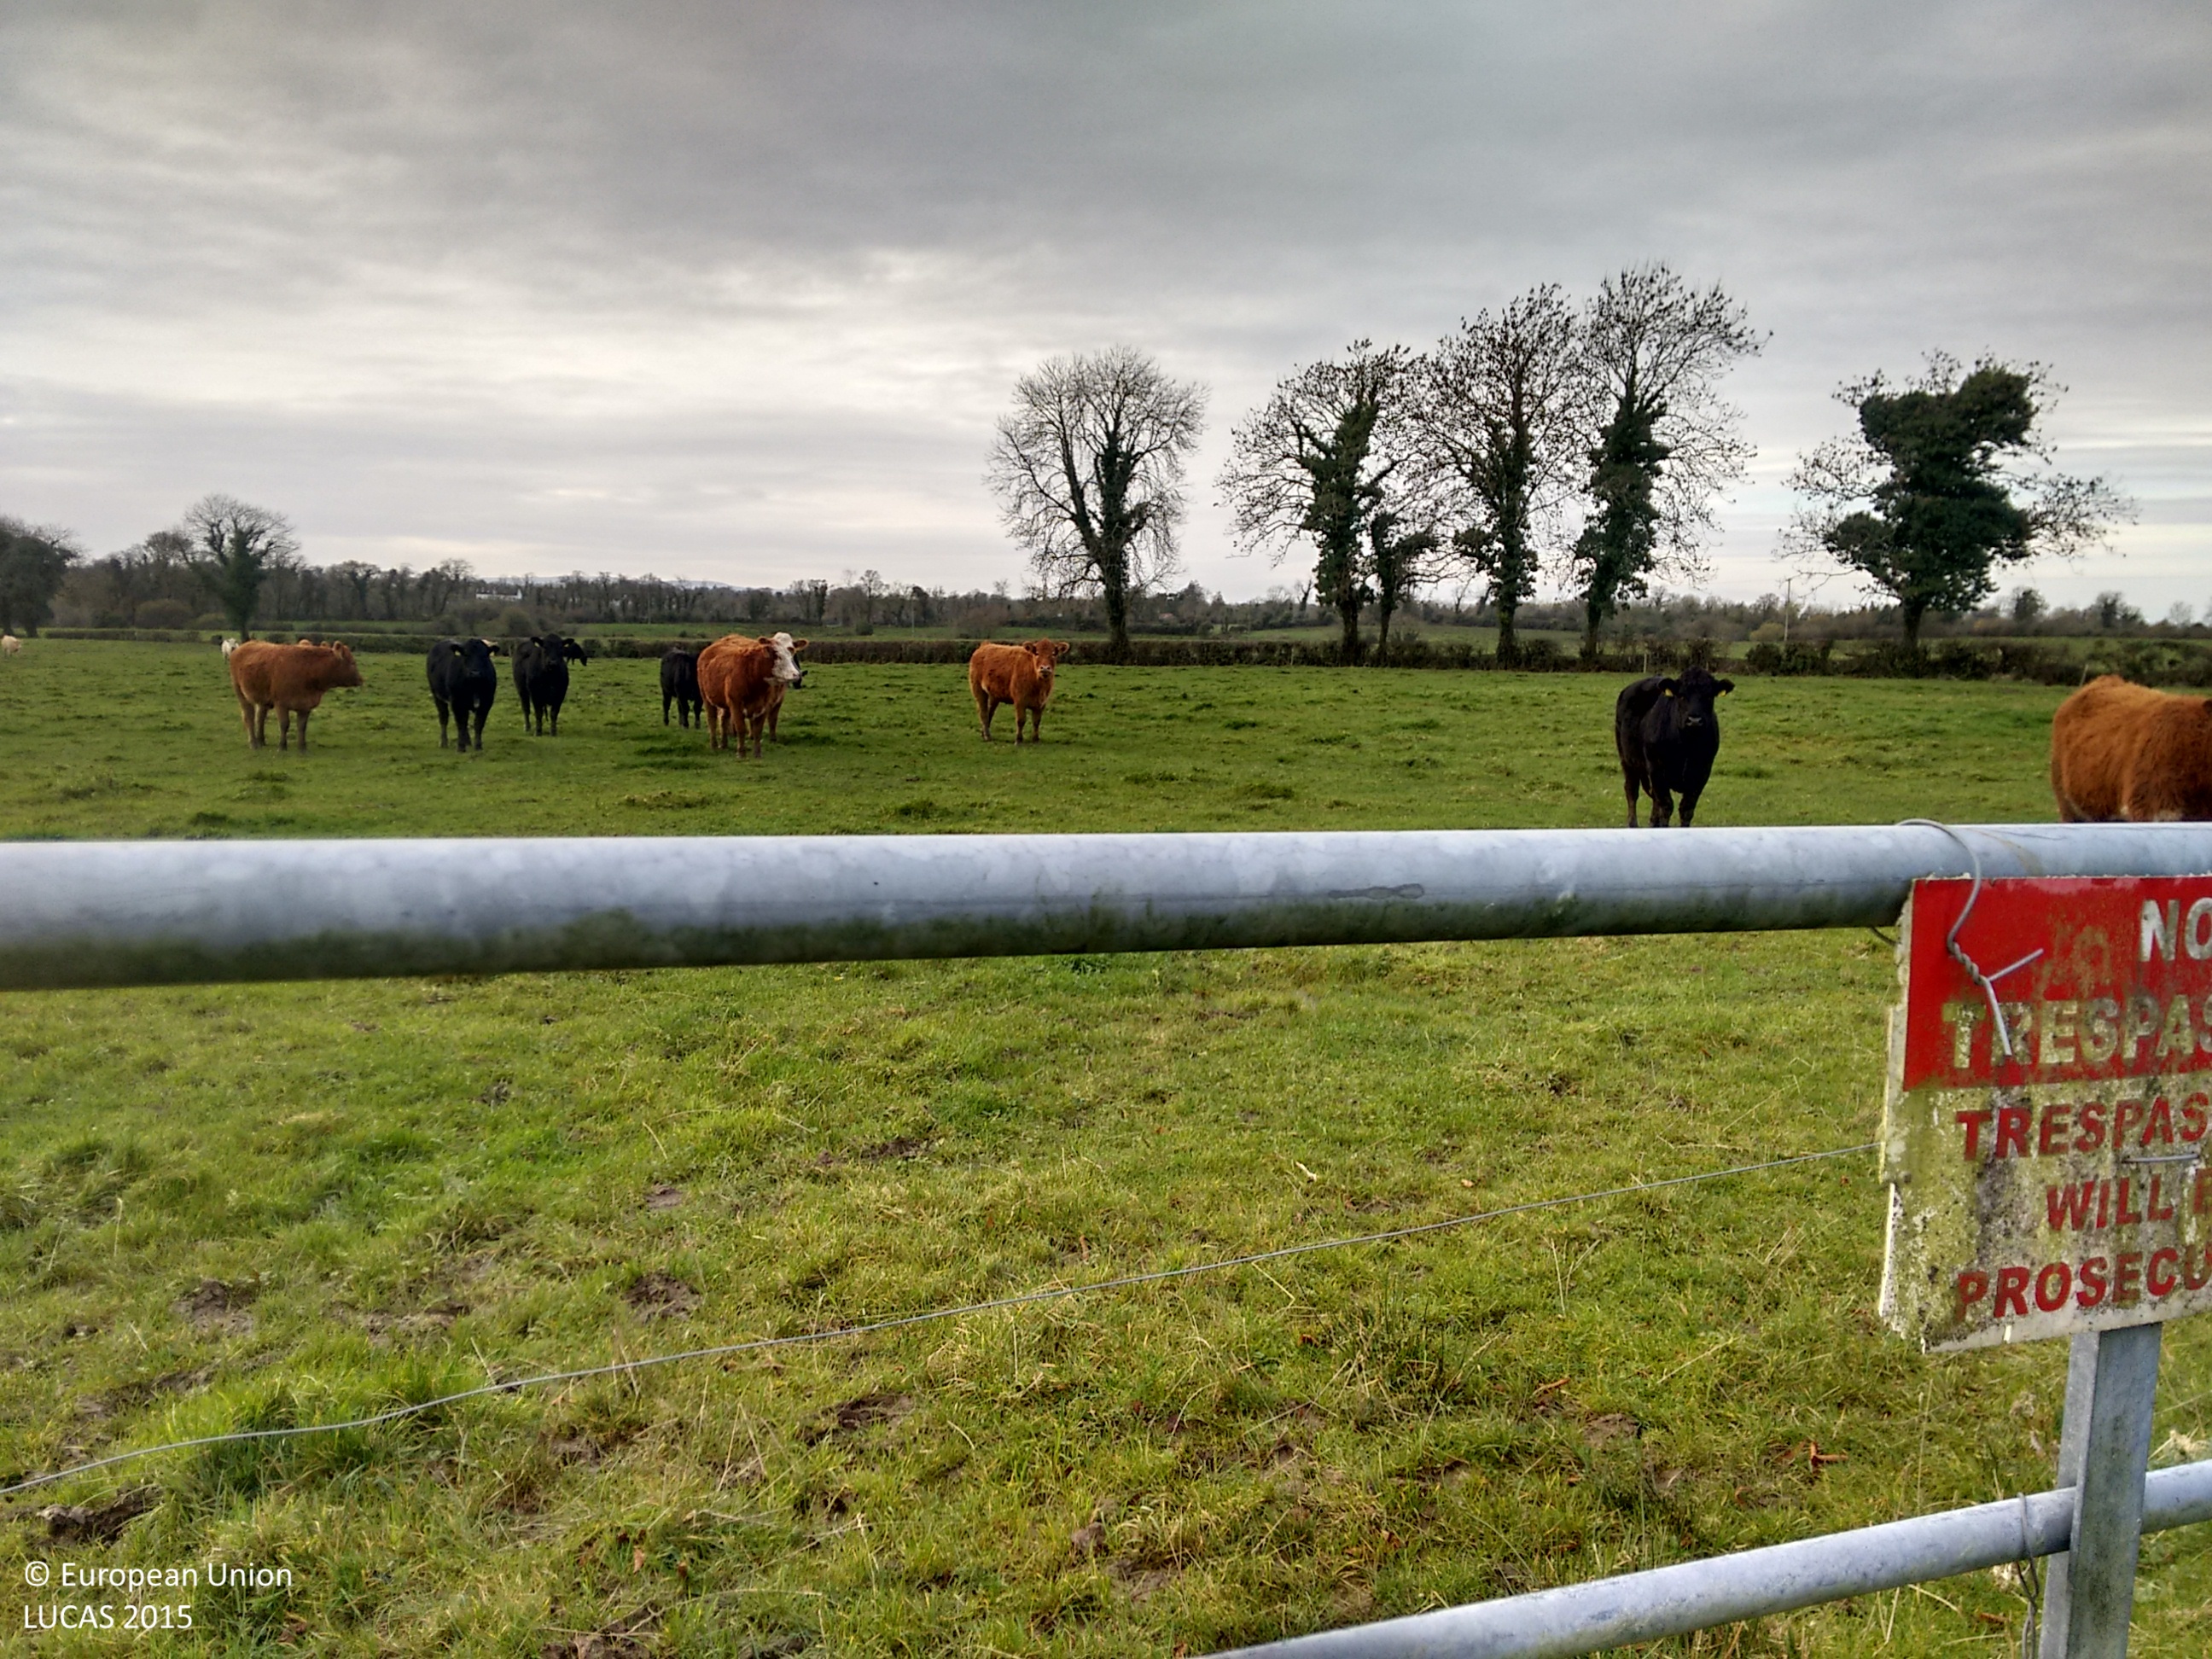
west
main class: Grassland
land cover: Grassland without tree/shrub cover
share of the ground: > 75 %
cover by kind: herbaceous plants 100 %
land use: Agriculture (excluding fallow land and kitchen gardens)
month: November
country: IE
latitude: 53.7671
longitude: -7.7806
